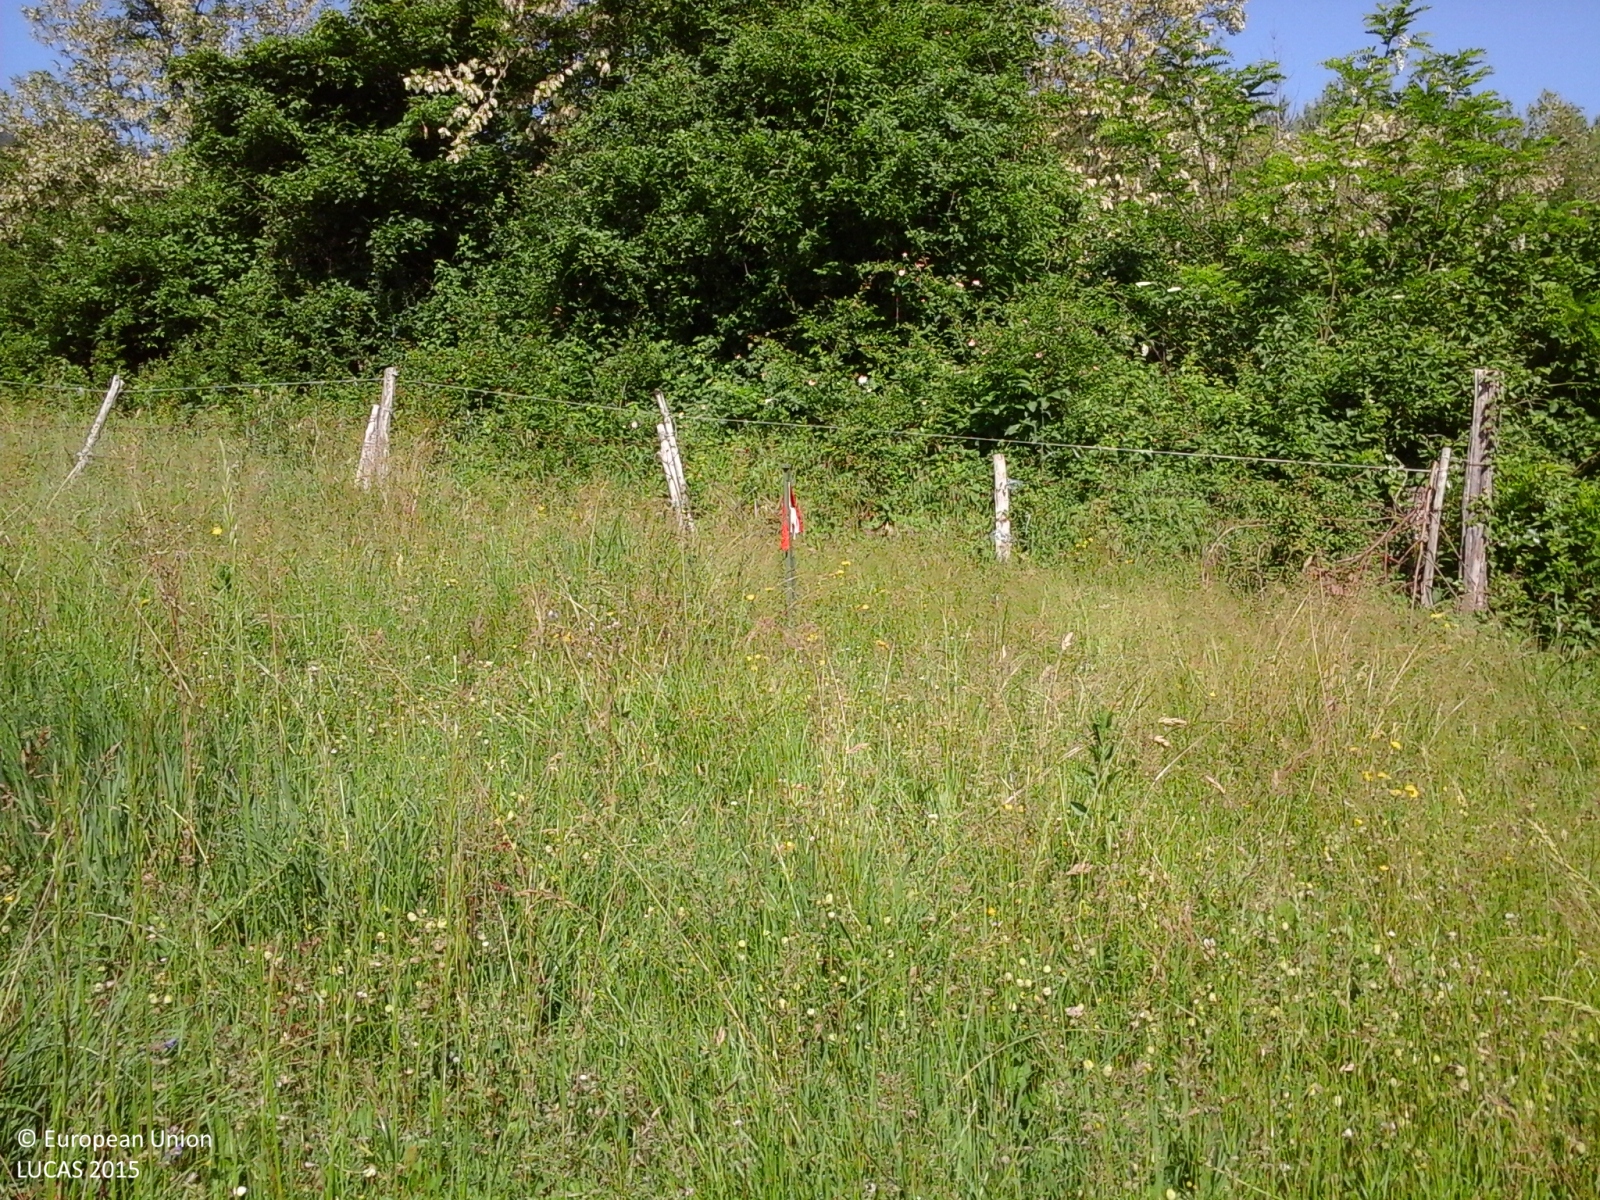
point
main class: Grassland
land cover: Grassland without tree/shrub cover
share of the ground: > 75 %
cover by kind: herbaceous plants 100 %
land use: Agriculture (excluding fallow land and kitchen gardens)
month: May
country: IT
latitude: 44.0083
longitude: 11.9037
